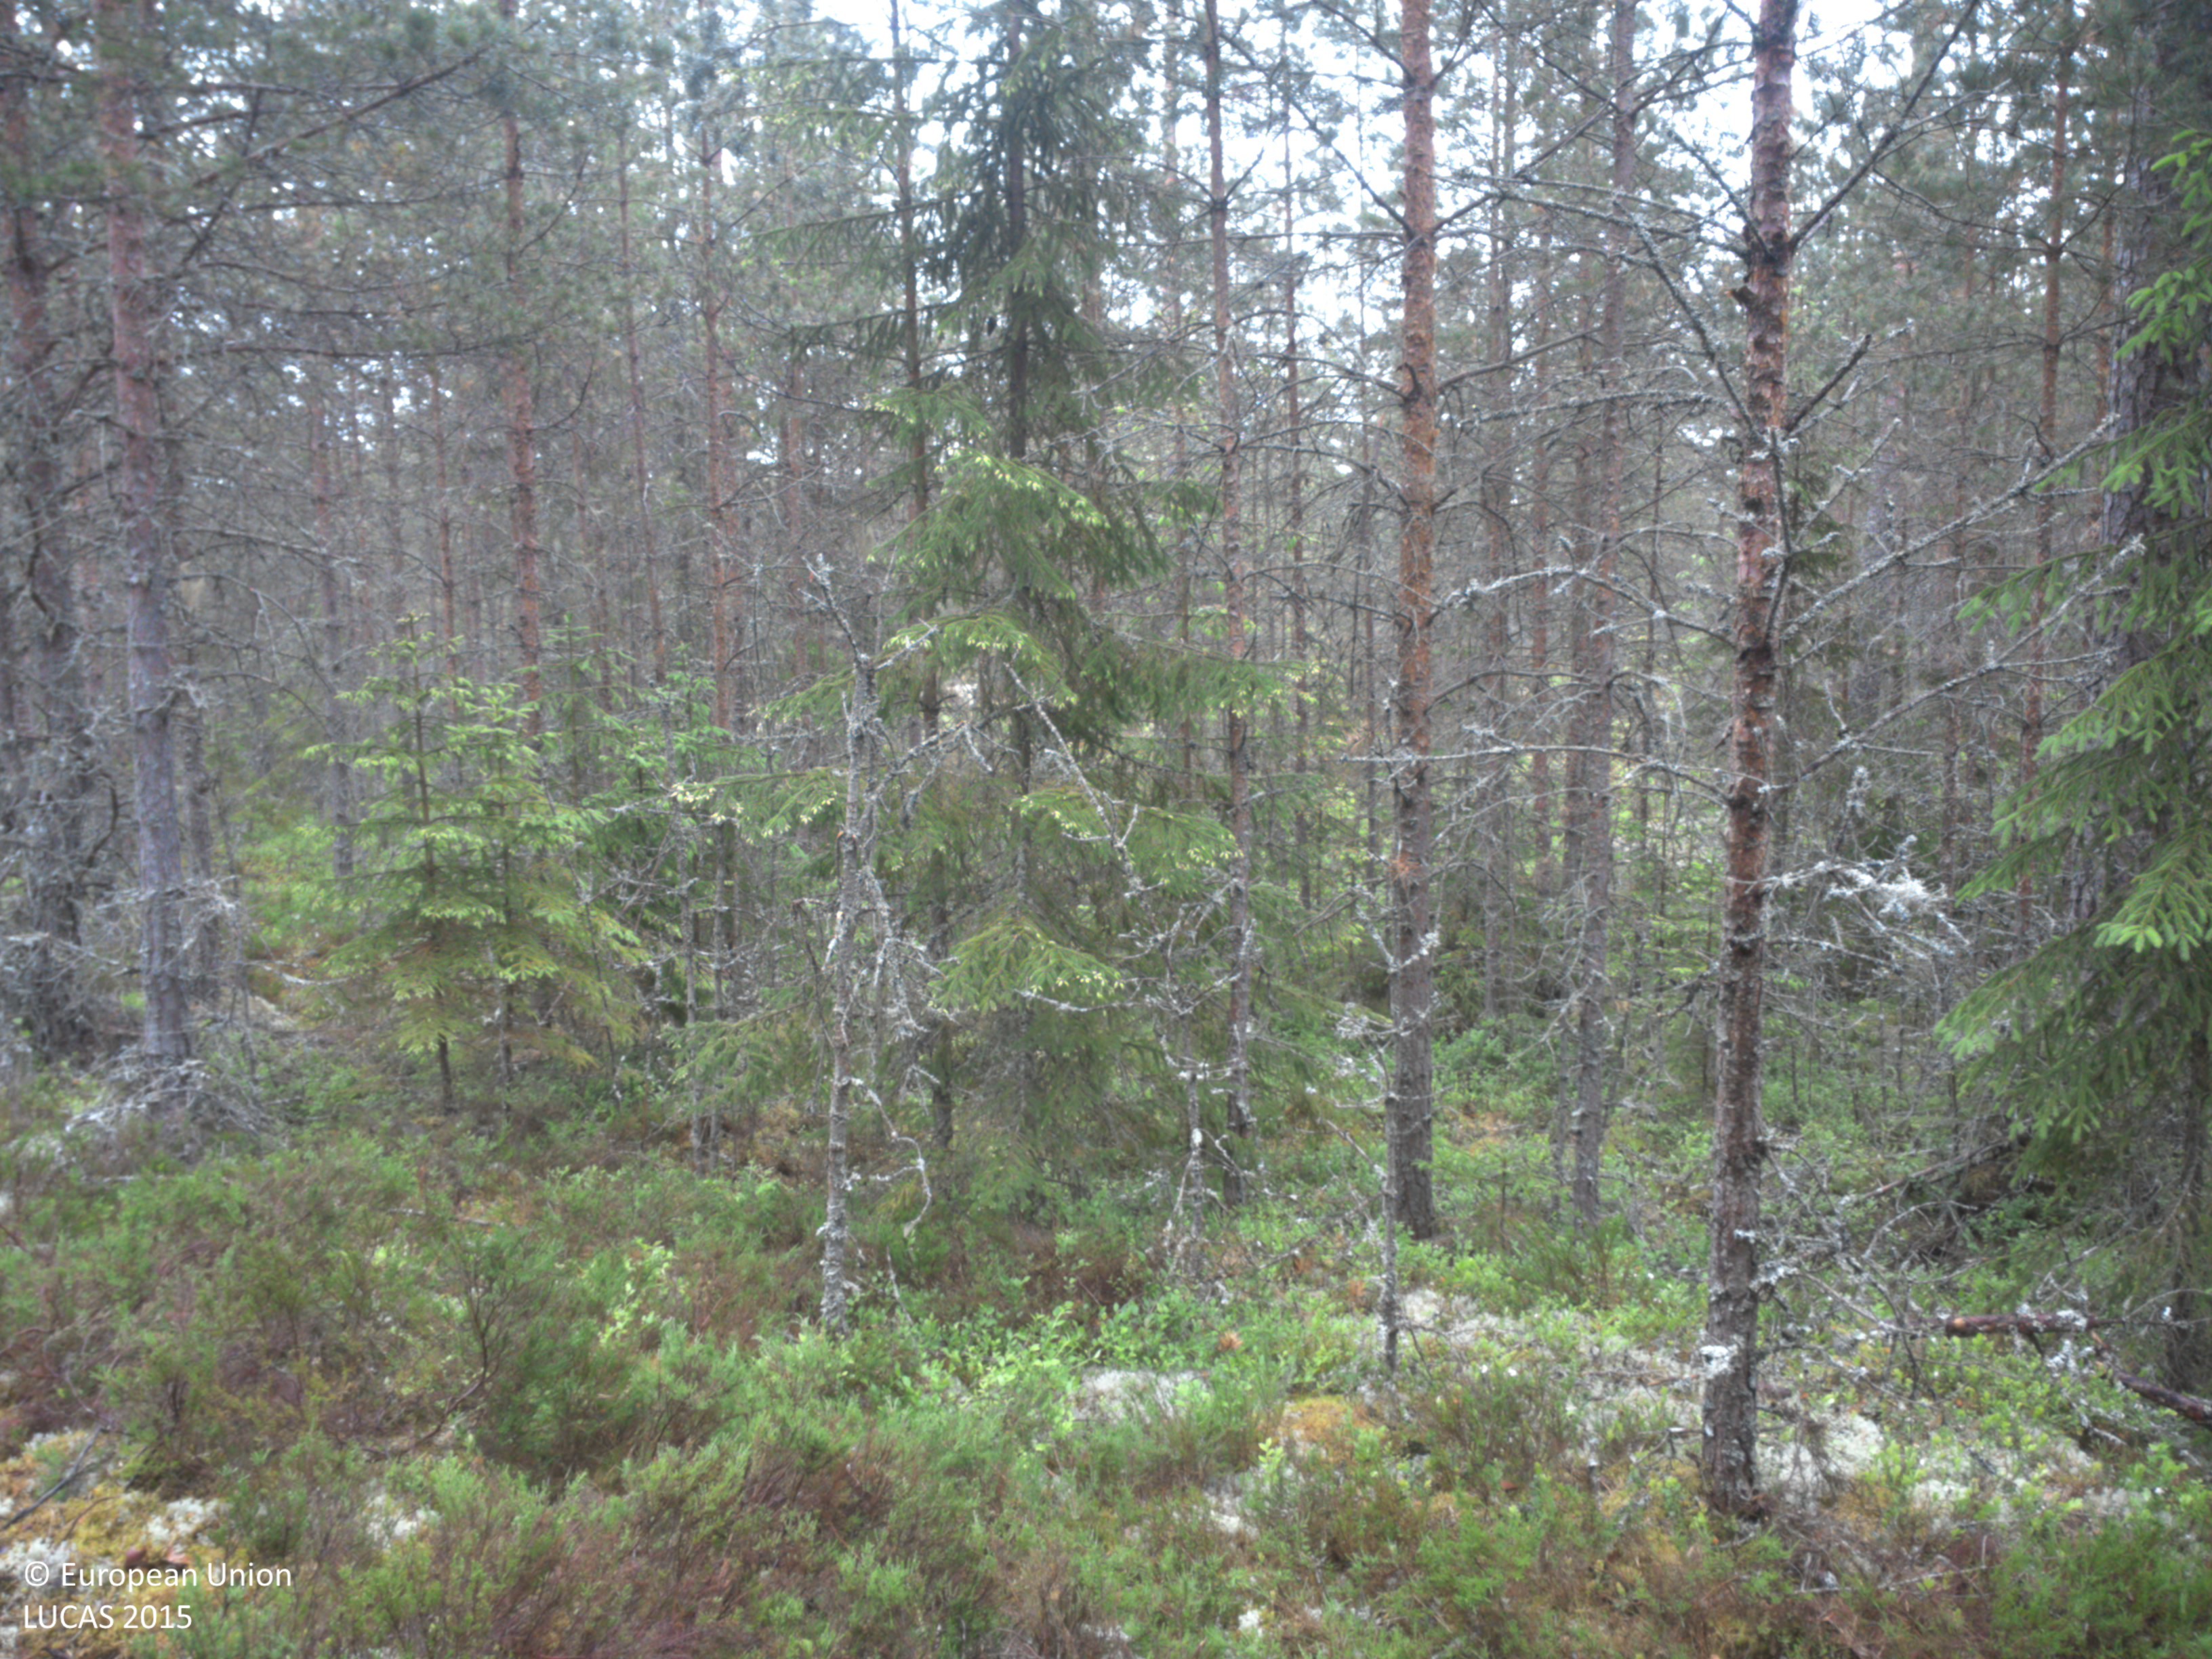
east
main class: Woodland
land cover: Pine dominated coniferous woodland
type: boreal forest
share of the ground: 50 - 75 %
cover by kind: coniferous forest trees 50 %, lichens and mosses 30 %, shrubs 20 %
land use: Forestry
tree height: > 5 m
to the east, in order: Pine dominated coniferous woodland; Spruce dominated coniferous woodland; Spruce dominated mixed woodland; Pine dominated mixed woodland; Pine dominated coniferous woodland
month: June
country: SE
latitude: 59.1038
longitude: 12.0379
